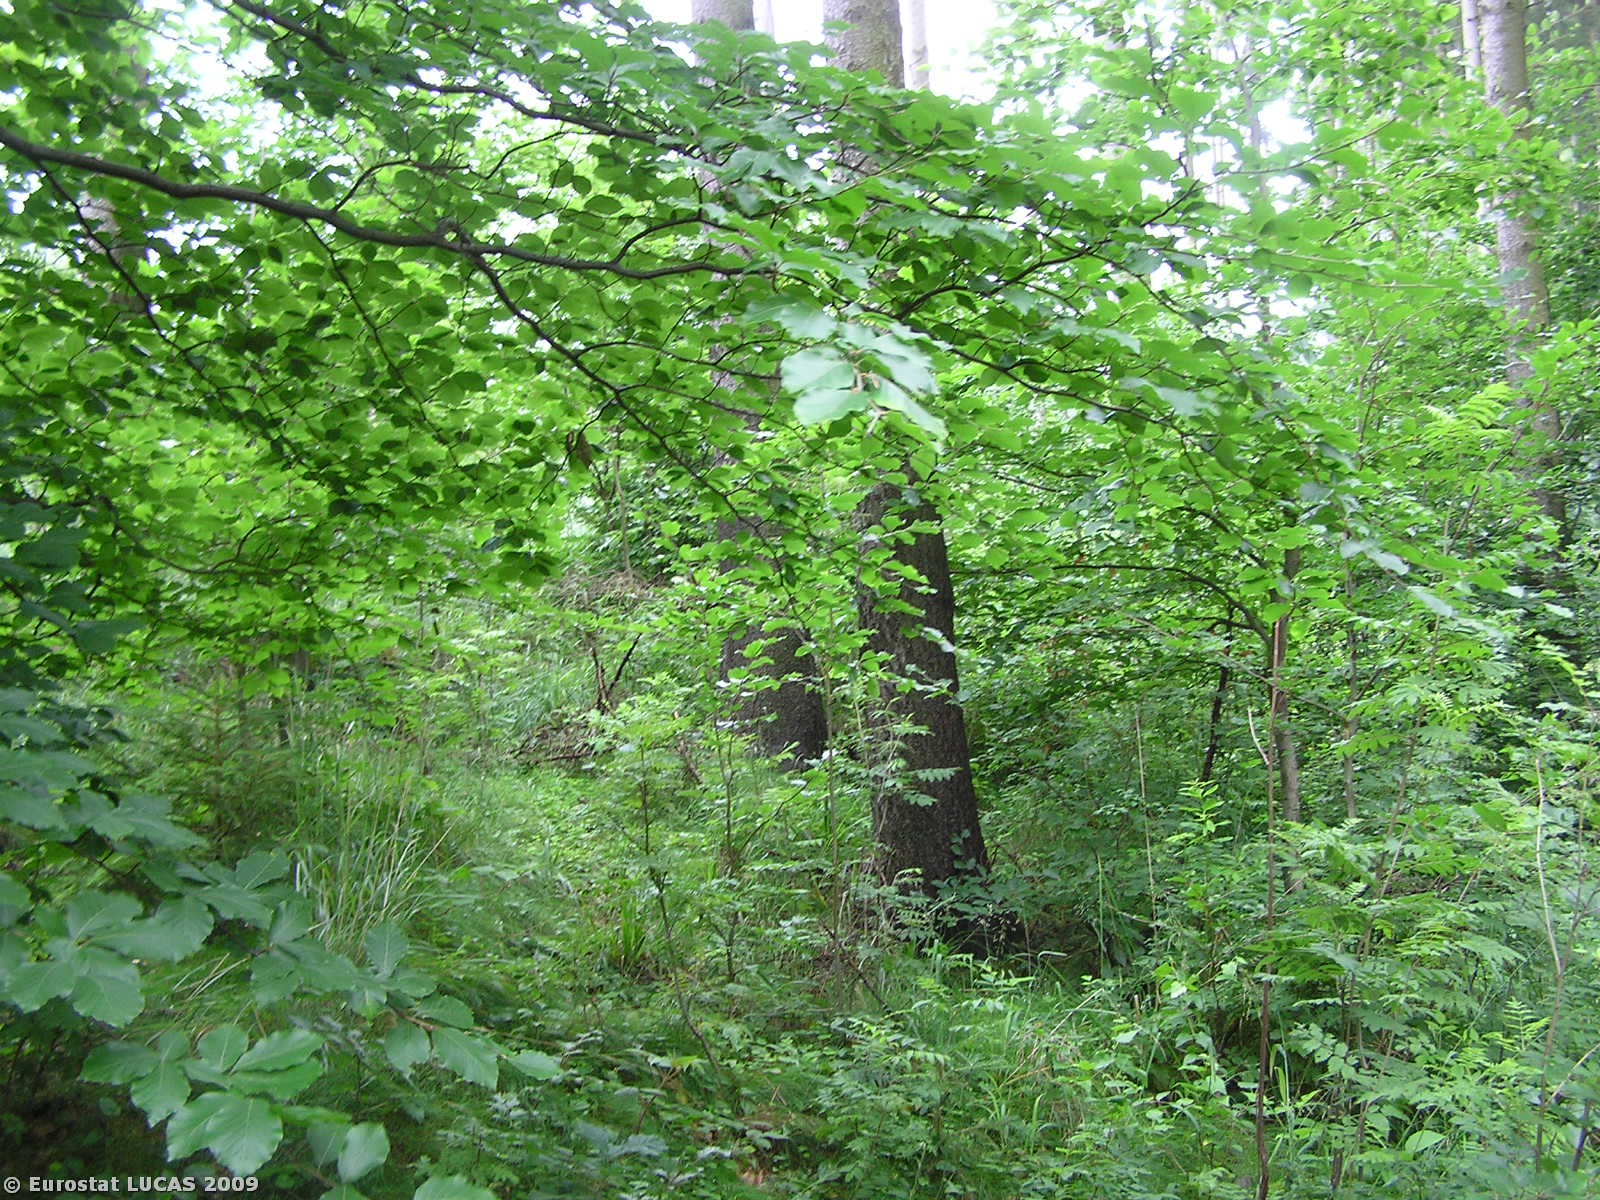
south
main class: Woodland
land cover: Mixed woodland
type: hemiboreal forest and nemoral coniferous forest and mixed broadleaved-coniferous forest
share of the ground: > 75 %
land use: Forestry
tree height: > 5 m
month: June
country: CZ
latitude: 50.1038
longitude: 17.4362
